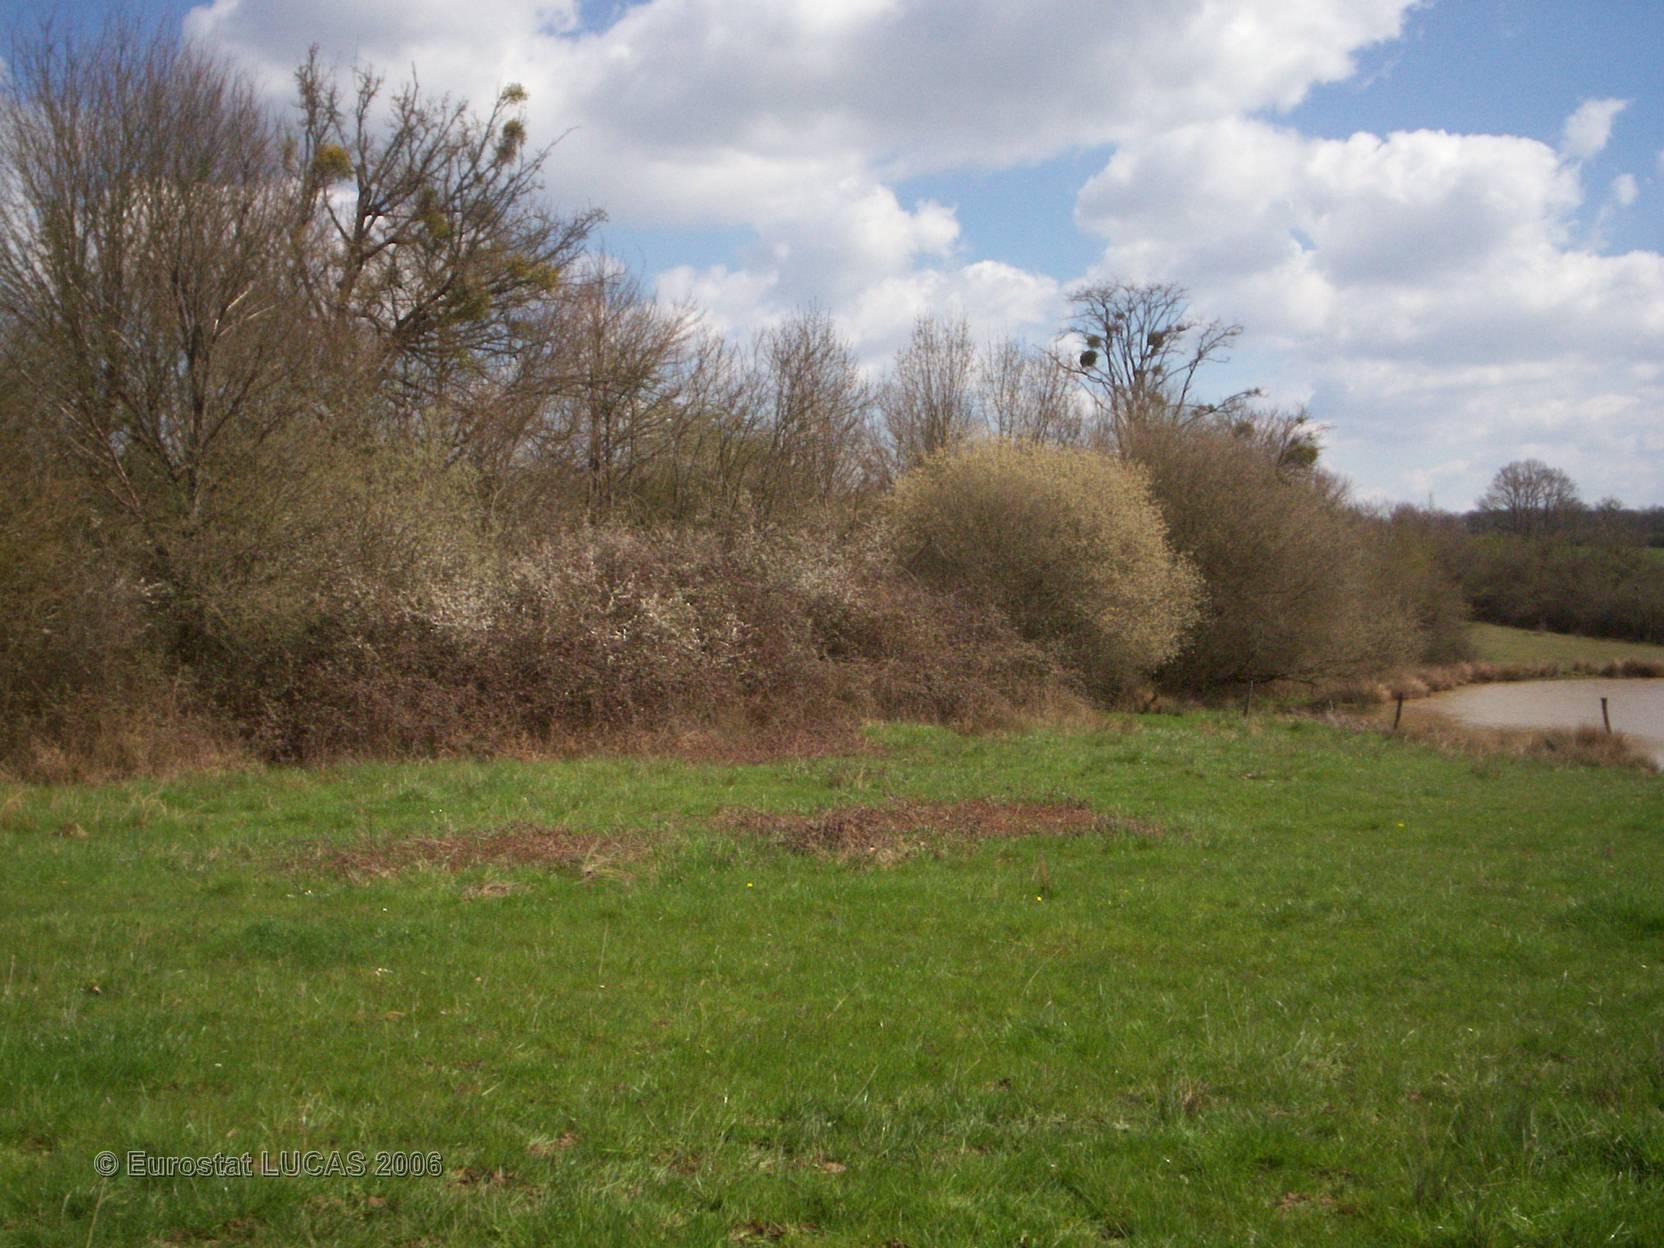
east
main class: Grassland
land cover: Grassland without tree/shrub cover
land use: Agriculture (excluding fallow land and kitchen gardens)
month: April
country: FR
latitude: 46.7606
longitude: 3.0968
